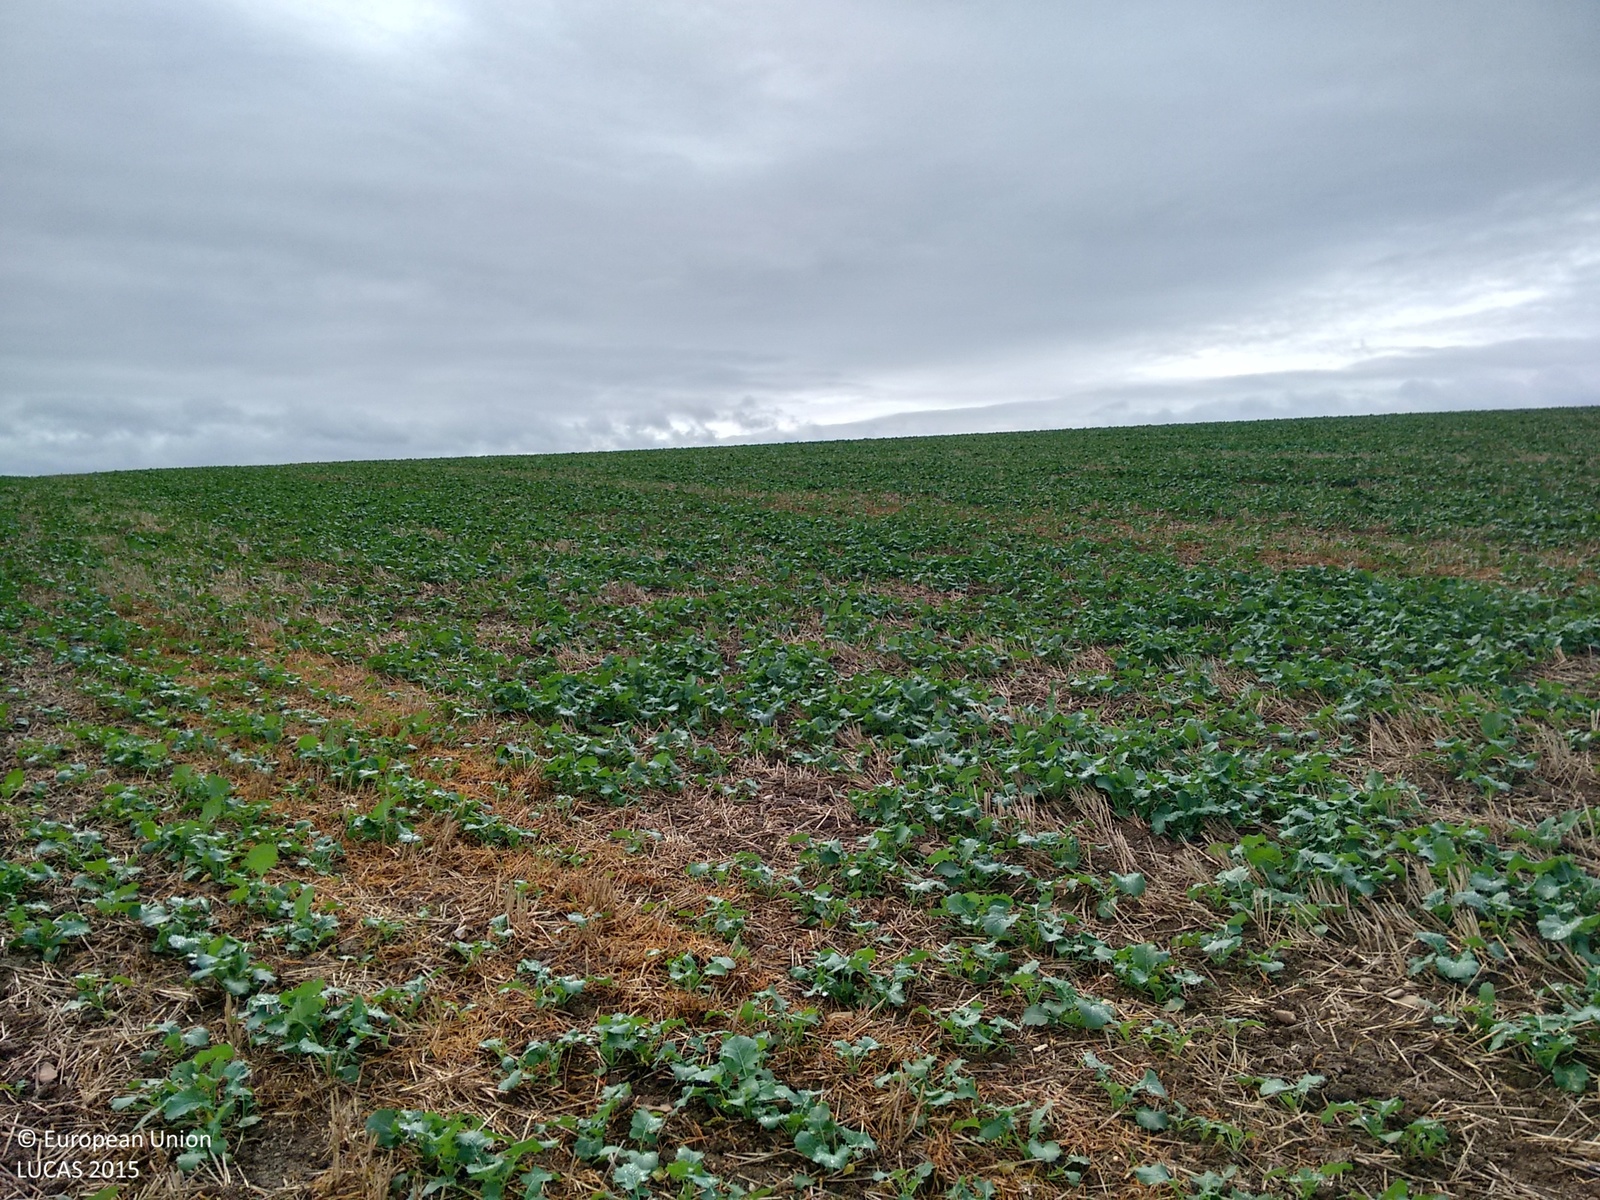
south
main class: Cropland
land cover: Rape and turnip rape
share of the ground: 50 - 75 %
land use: Agriculture (excluding fallow land and kitchen gardens)
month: October
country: GB
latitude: 52.0356
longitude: -1.6718
